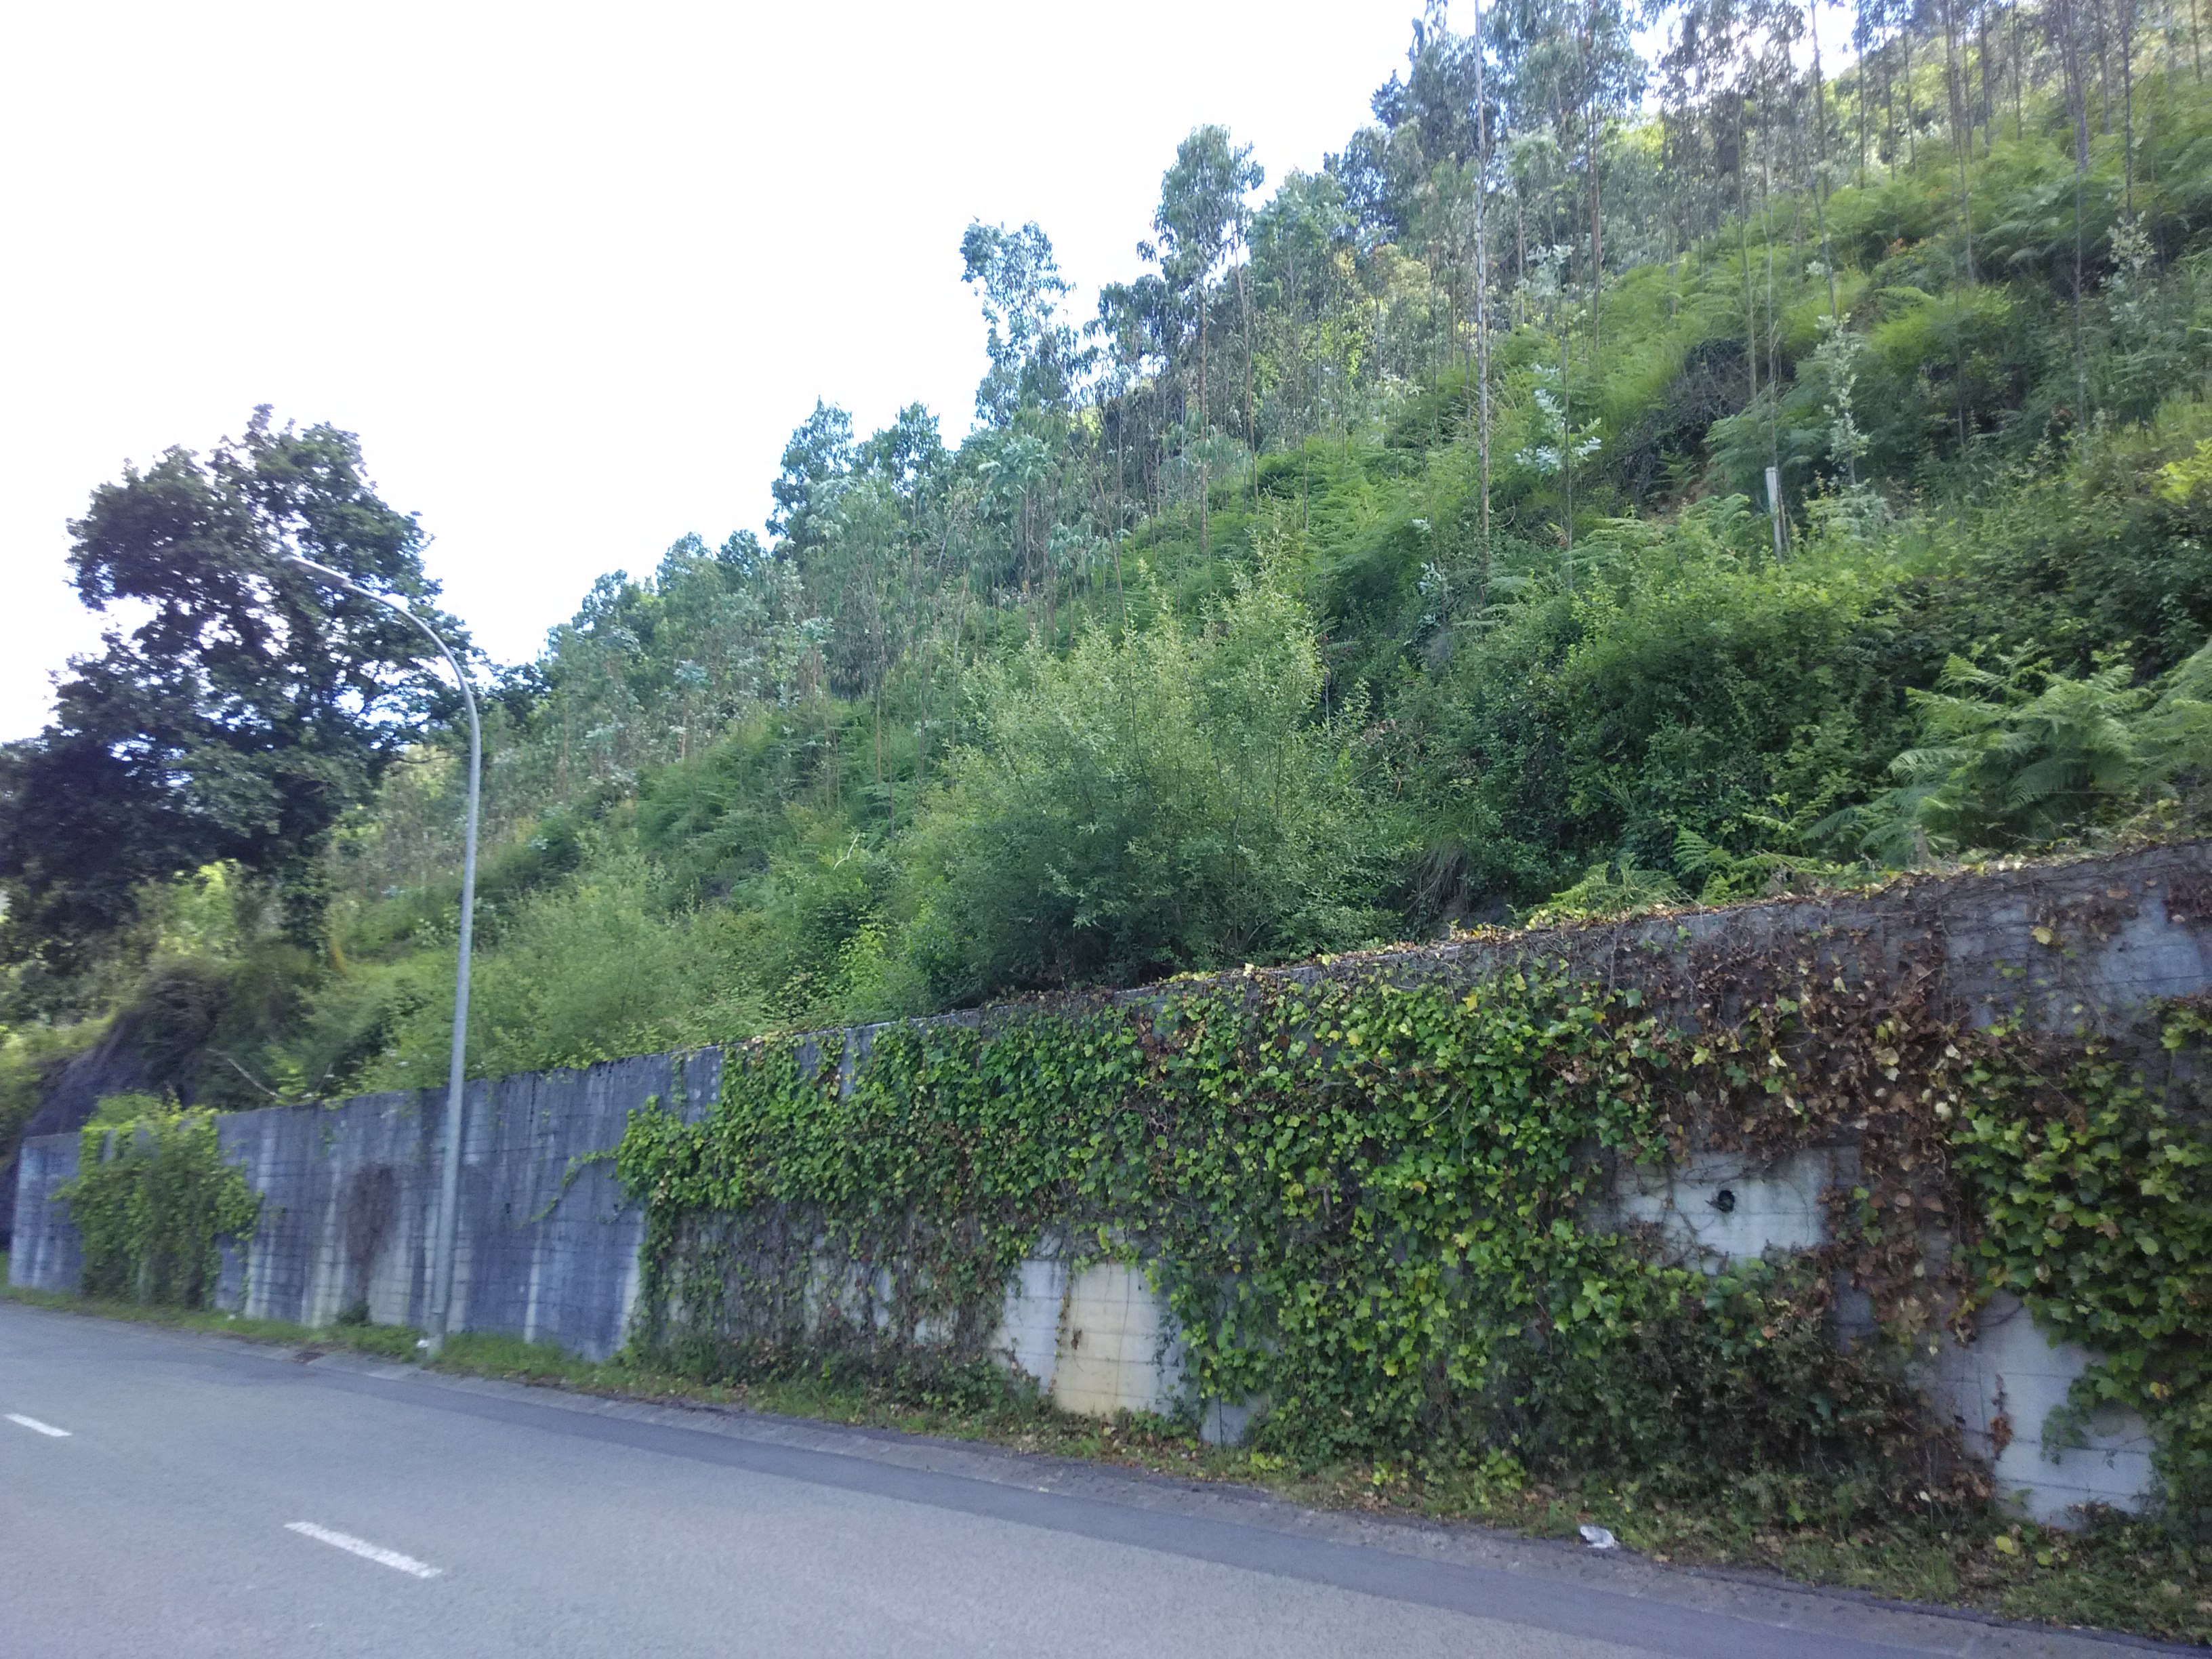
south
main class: Woodland
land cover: Broadleaved woodland
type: exotic forest
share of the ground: > 75 %
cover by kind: broadleaved forest trees 100 %
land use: Forestry
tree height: < 5 m
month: June
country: ES
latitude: 43.3303
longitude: -2.5475
